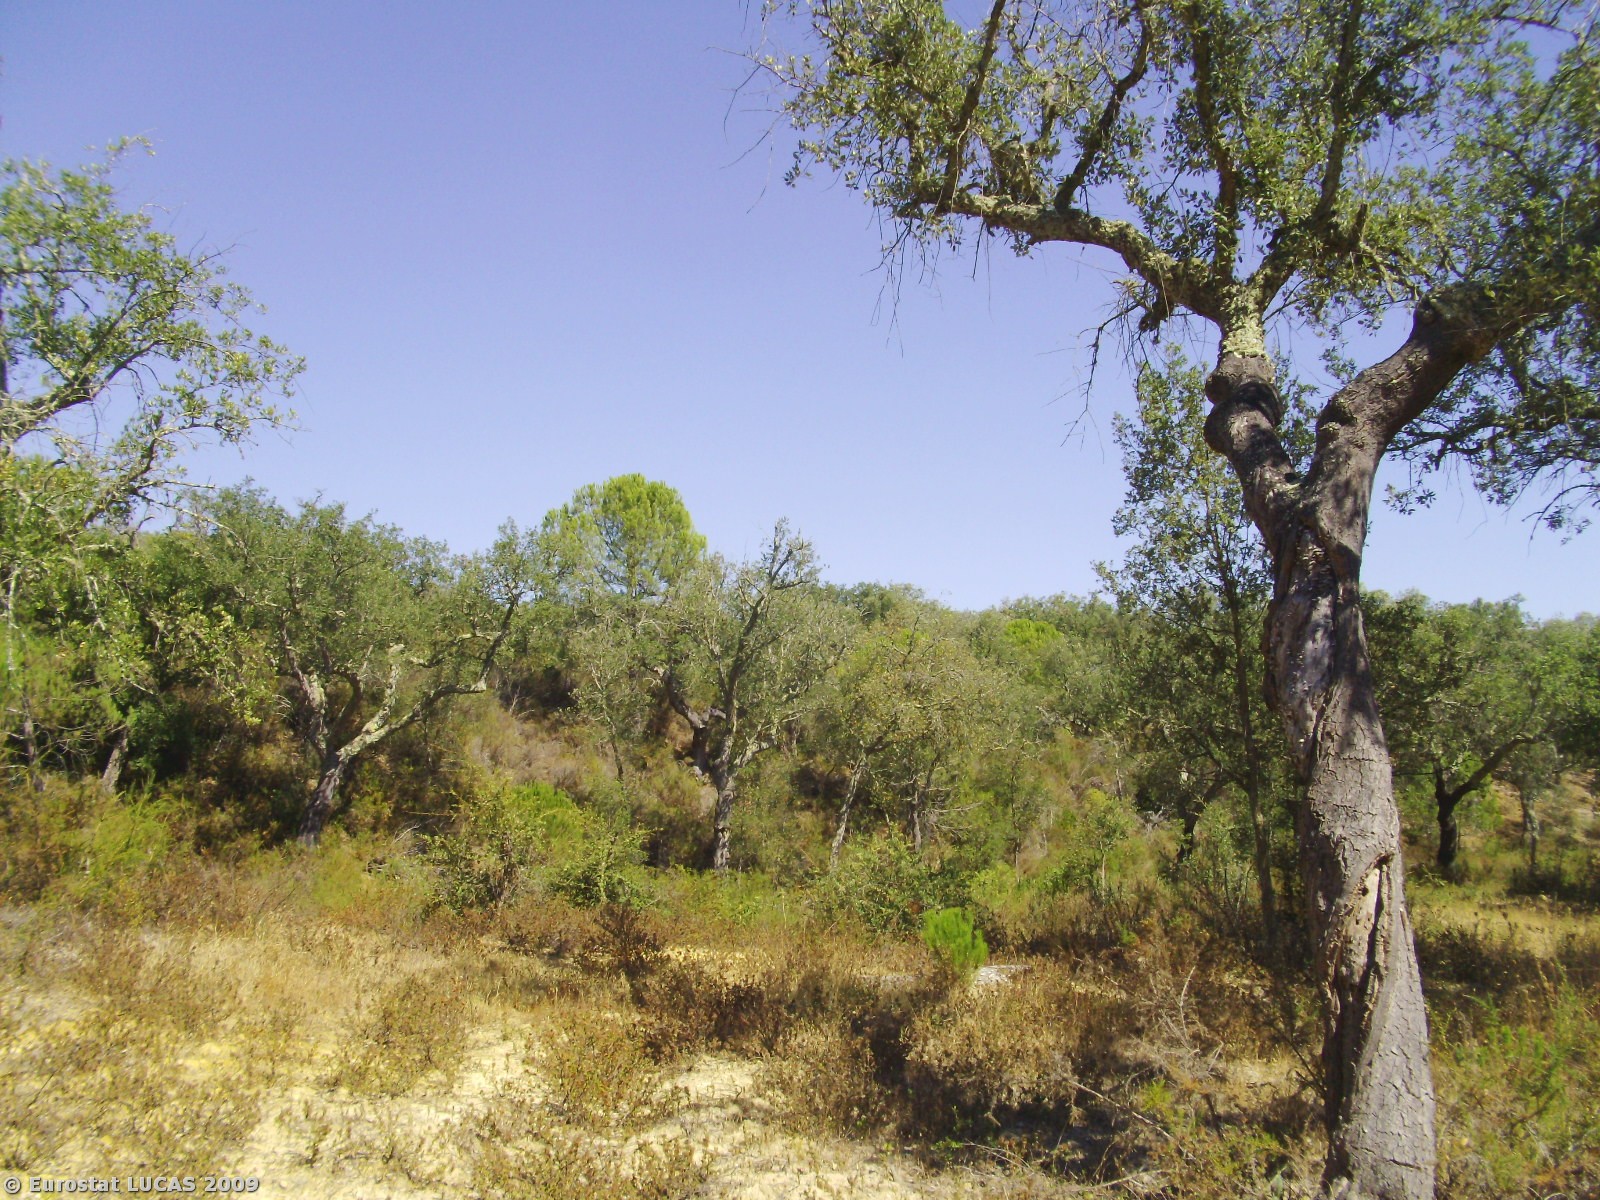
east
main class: Woodland
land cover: Broadleaved woodland
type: broadleaved evergreen forest
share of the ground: 50 - 75 %
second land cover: Spontaneously vegetated surfaces
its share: 50 - 75 %
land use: Forestry
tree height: > 5 m
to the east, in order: Broadleaved woodland; Spontaneously vegetated surfaces; Broadleaved woodland; Rivers and streams; Broadleaved woodland
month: July
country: PT
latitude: 38.3151
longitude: -8.4505
